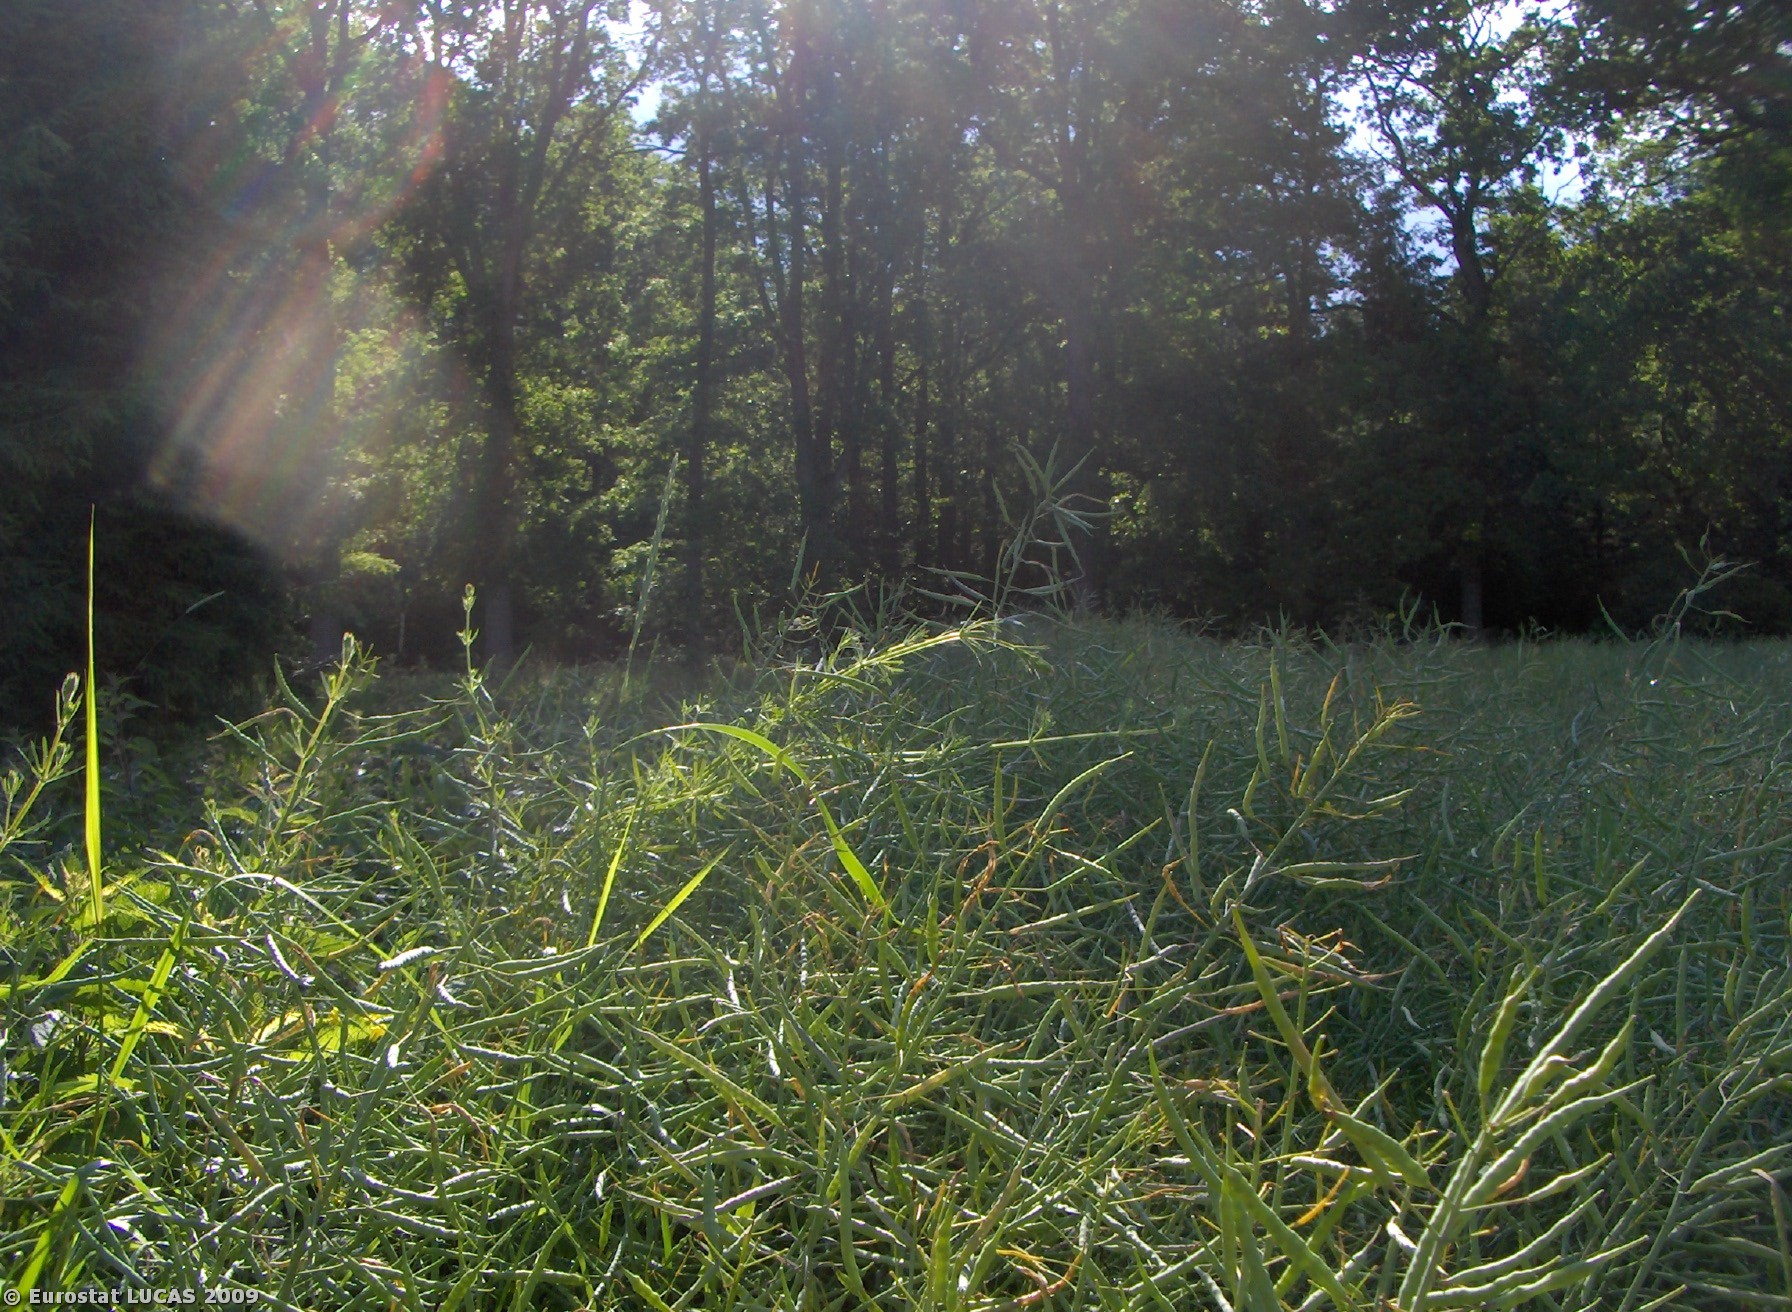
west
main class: Cropland
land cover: Rape and turnip rape
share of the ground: > 75 %
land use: Agriculture (excluding fallow land and kitchen gardens)
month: June
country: CZ
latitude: 49.2069
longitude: 14.1872
